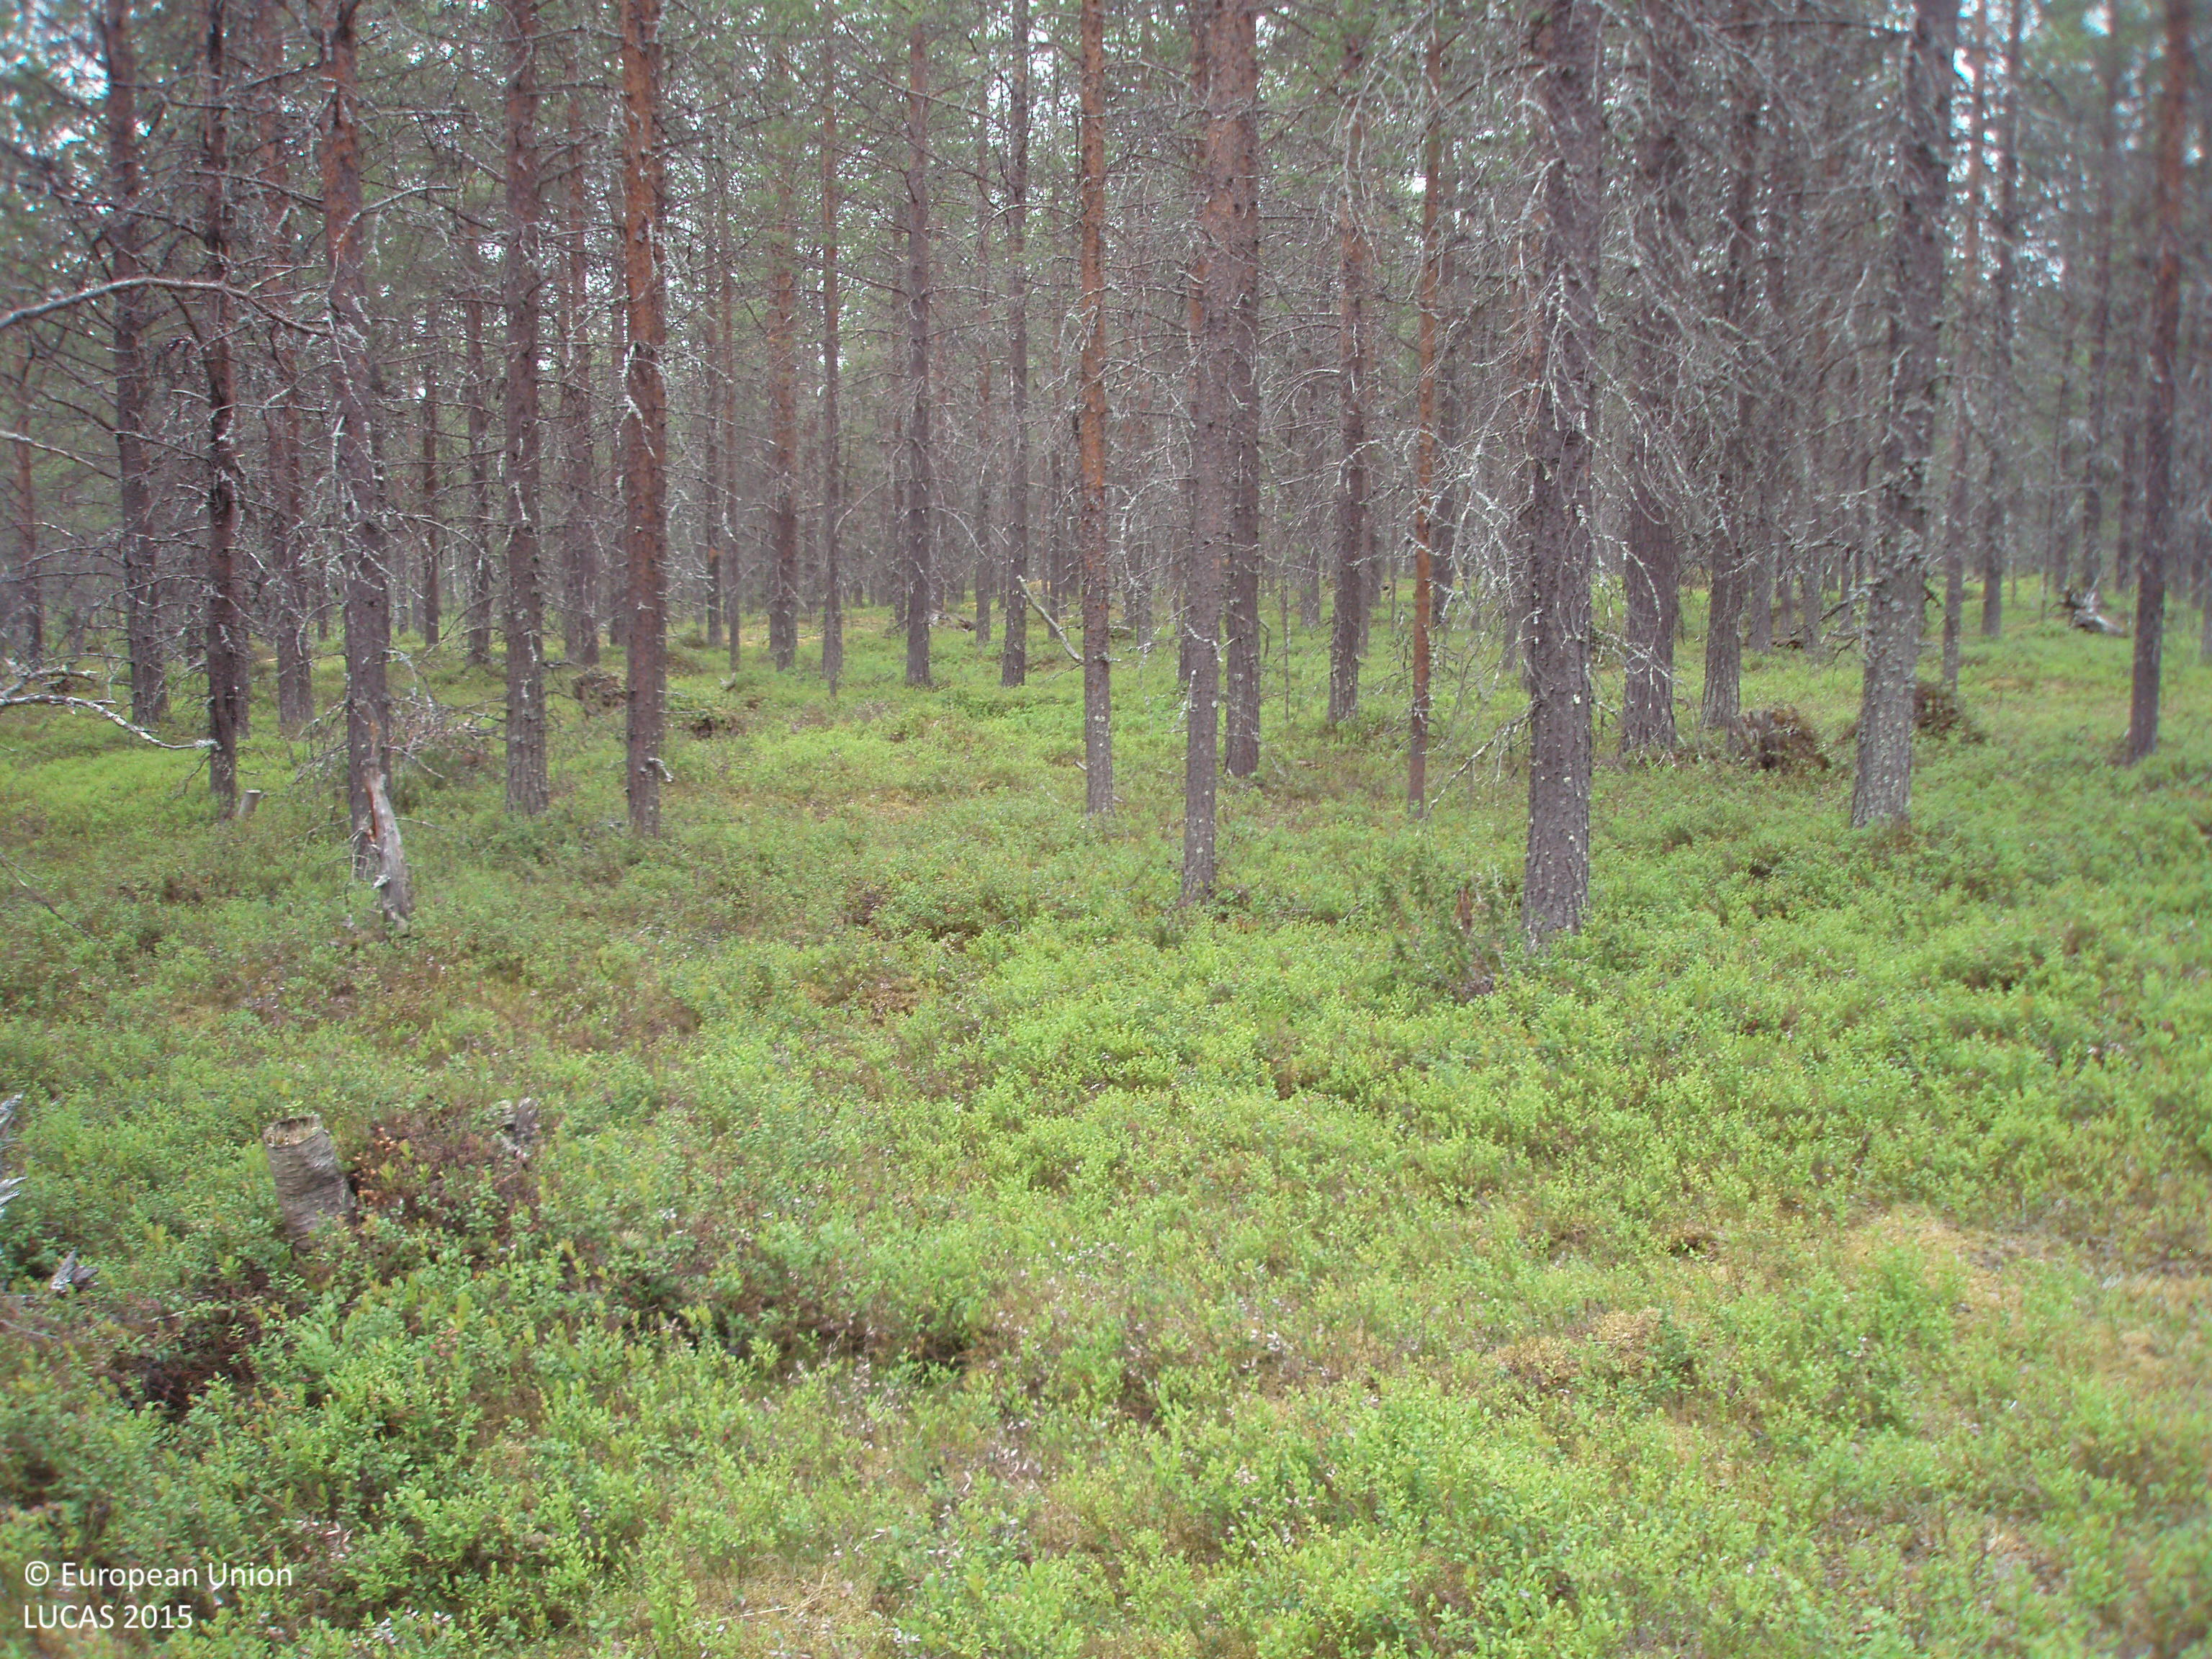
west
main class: Woodland
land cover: Pine dominated coniferous woodland
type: boreal forest
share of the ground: > 75 %
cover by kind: coniferous forest trees 80 %, shrubs 20 %
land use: Forestry
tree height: > 5 m
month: July
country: FI
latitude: 67.7029
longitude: 28.7687
